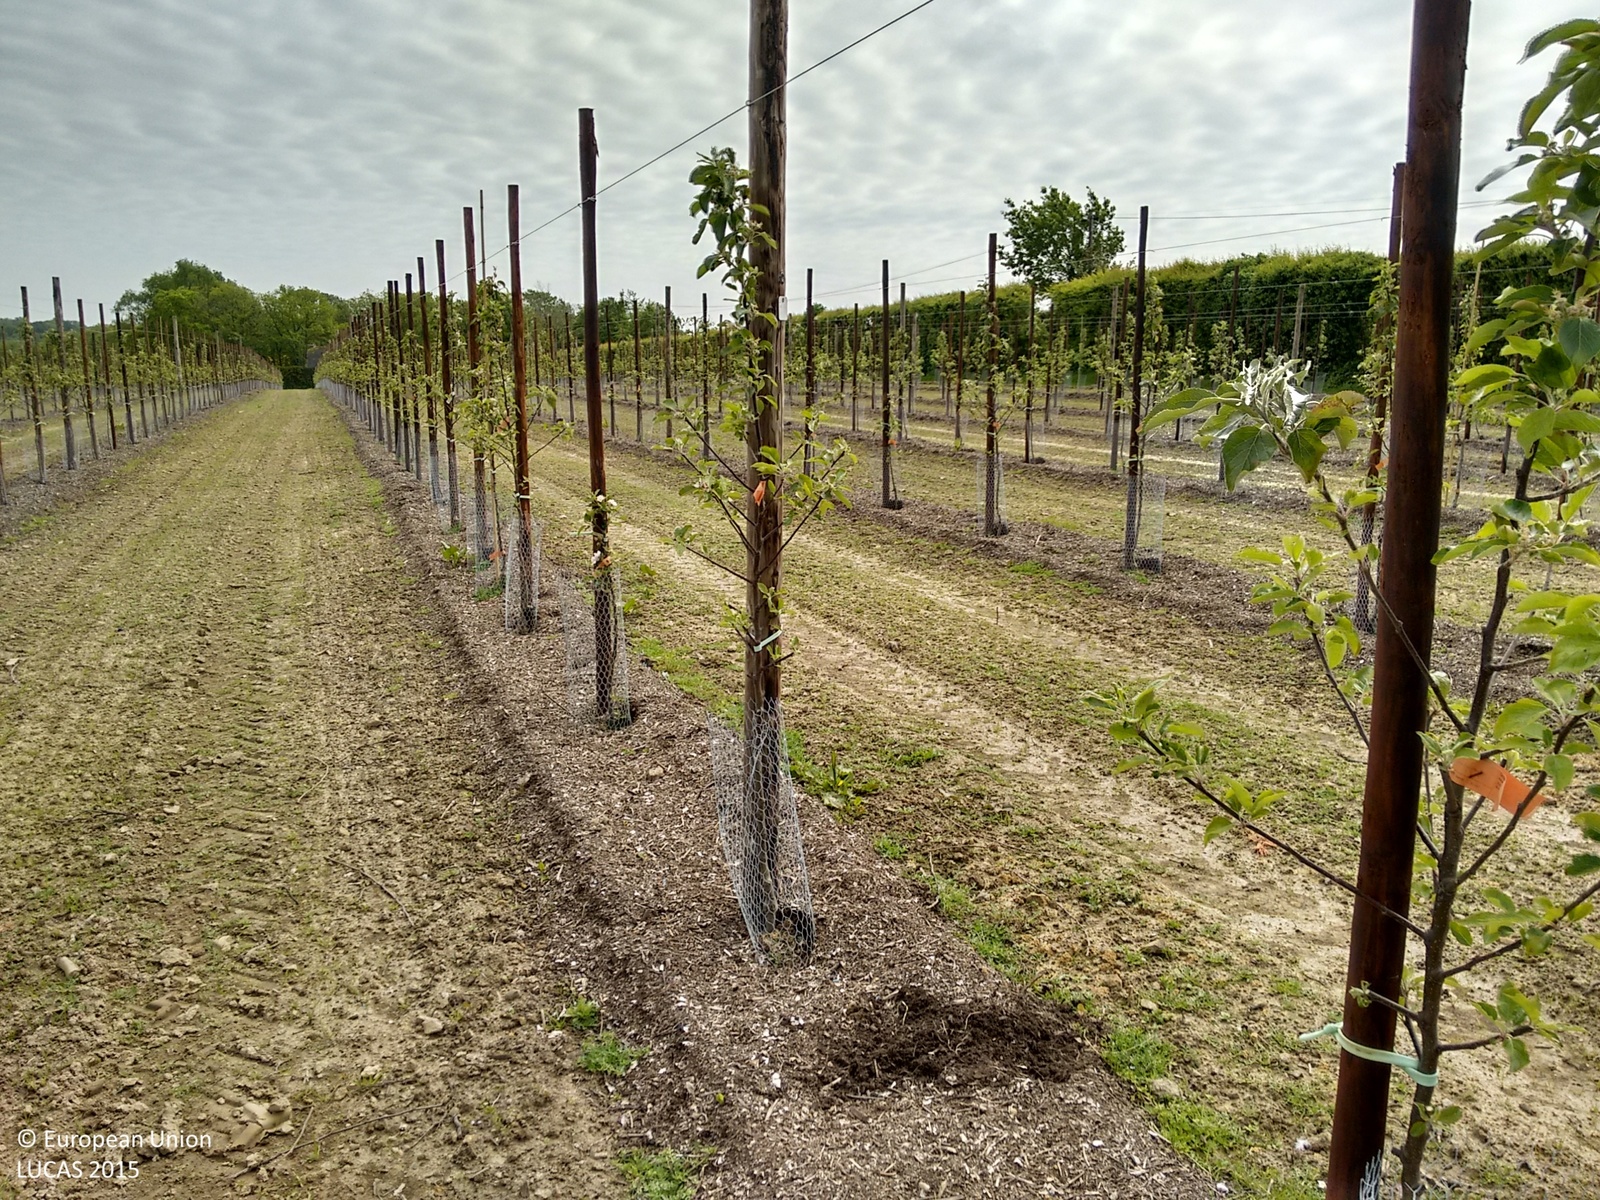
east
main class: Cropland
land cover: Apple fruit
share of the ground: < 10 %
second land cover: Spontaneously vegetated surfaces
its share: < 10 %
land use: Agriculture (excluding fallow land and kitchen gardens)
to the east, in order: Apple fruit; Spontaneously vegetated surfaces; Managed hedges; Electric lines; Grass margins; Paved roads, cycling and walking lanes; Grass margins; Broadleaved woodland; Grassland without tree/shrub cover; Apple fruit
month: May
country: GB
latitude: 51.1504
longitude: 0.3494
